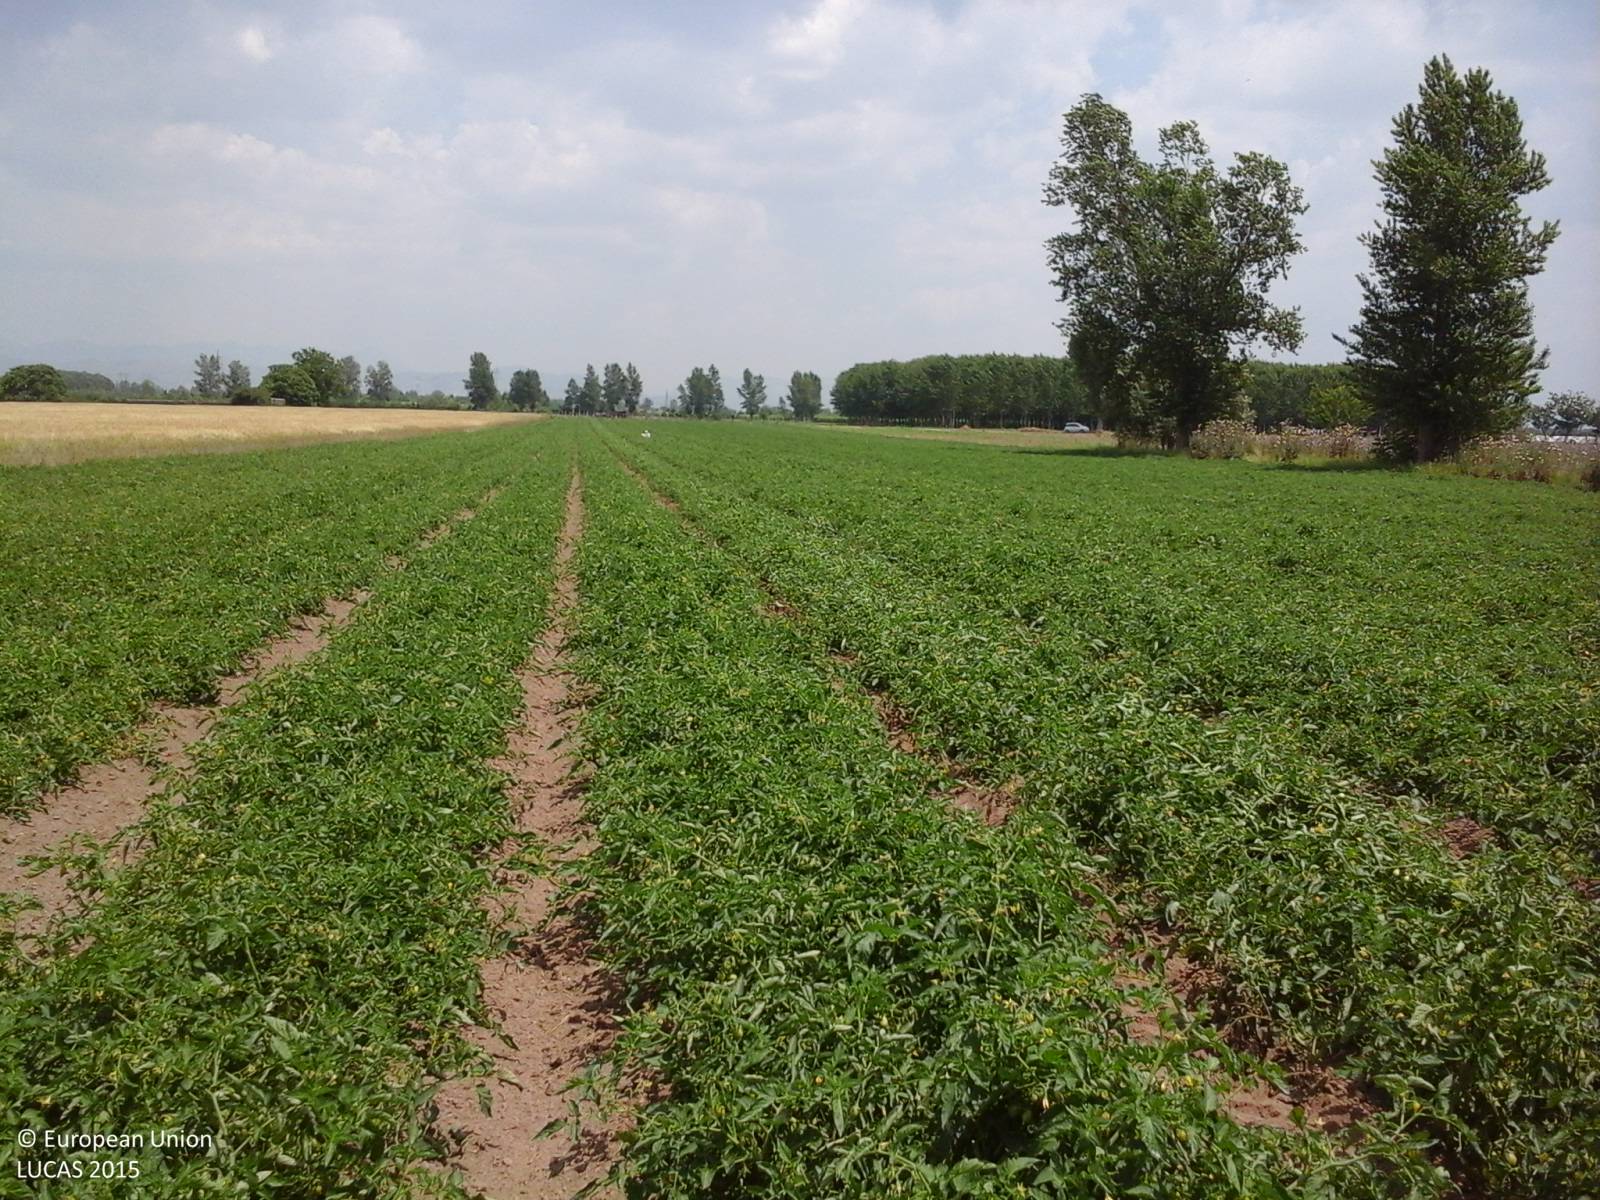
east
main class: Cropland
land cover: Tomatoes
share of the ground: > 75 %
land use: Agriculture (excluding fallow land and kitchen gardens)
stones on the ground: < 10 %
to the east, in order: Tomatoes; Grass margins; Tracks
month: June
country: IT
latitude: 41.0296
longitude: 14.1816
